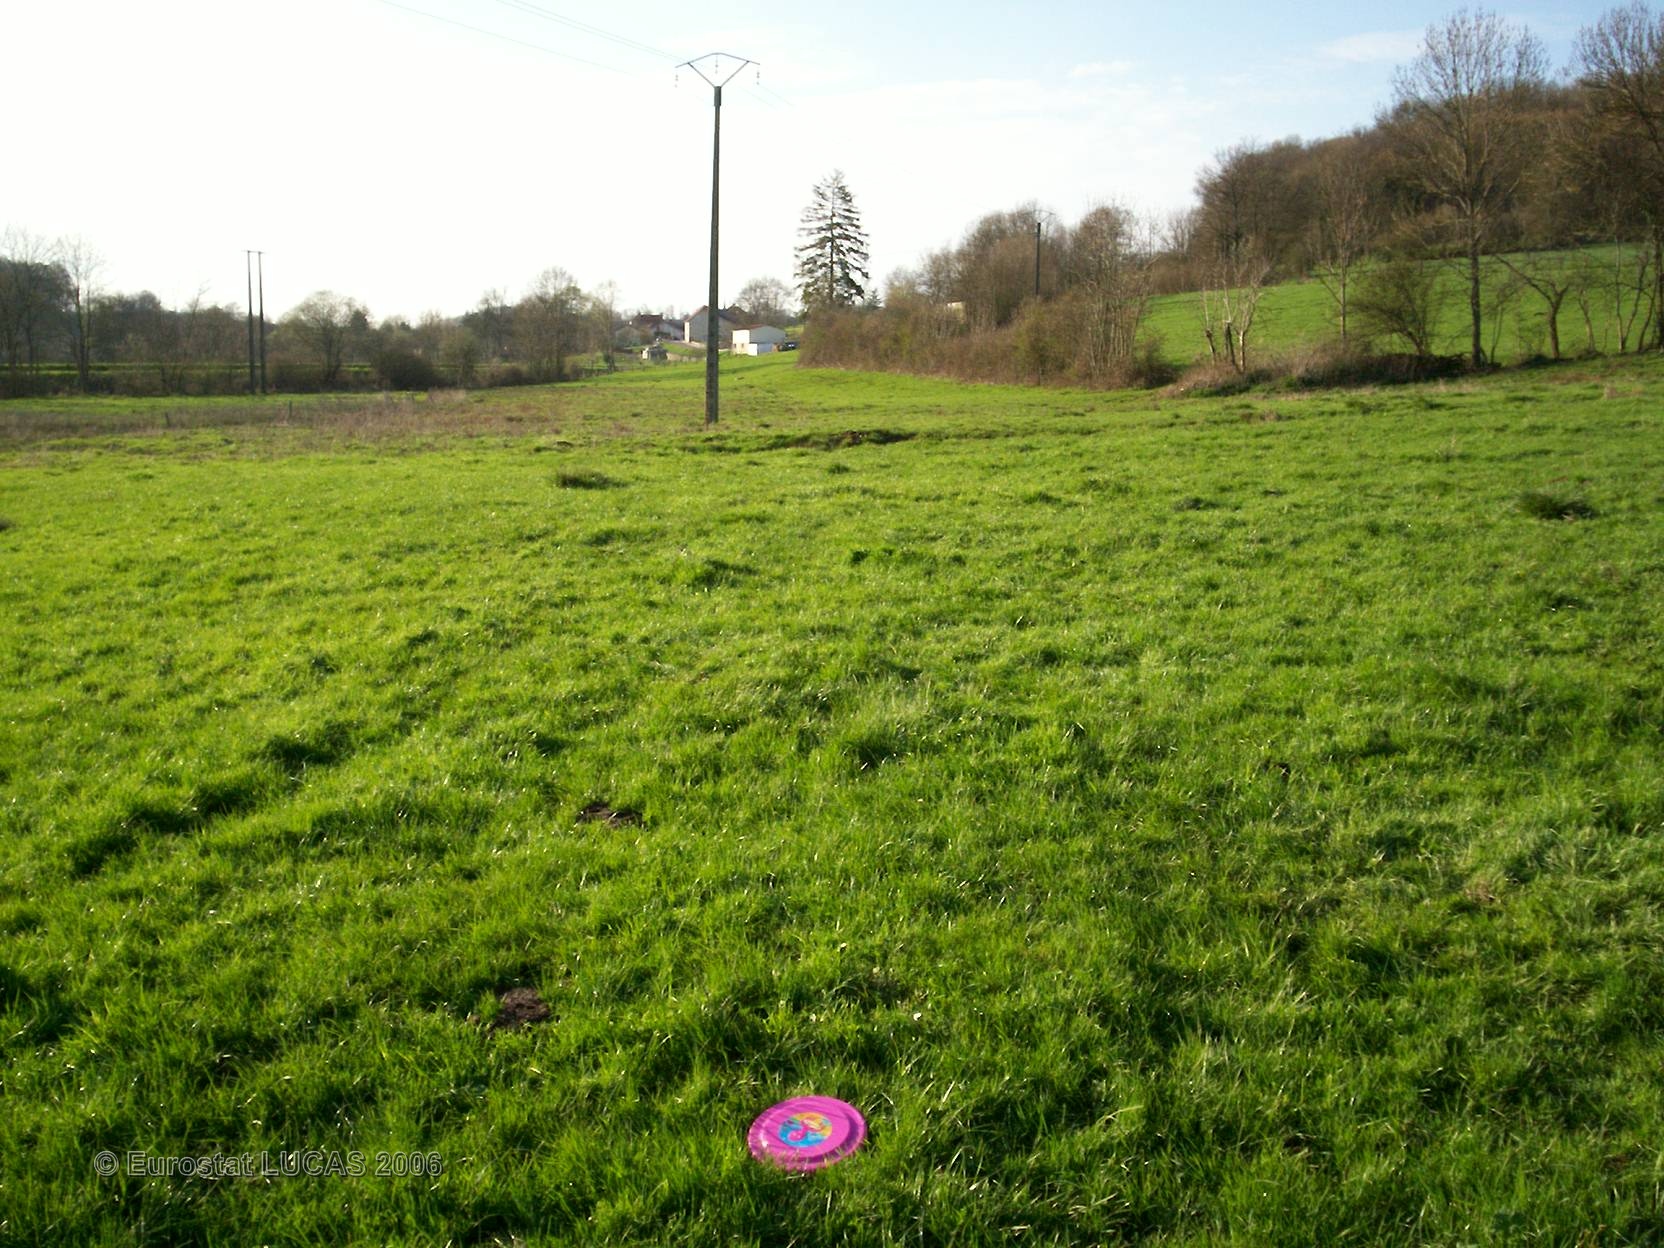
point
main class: Grassland
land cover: Grassland without tree/shrub cover
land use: Agriculture (excluding fallow land and kitchen gardens)
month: April
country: FR
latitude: 47.9958
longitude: 5.2689
